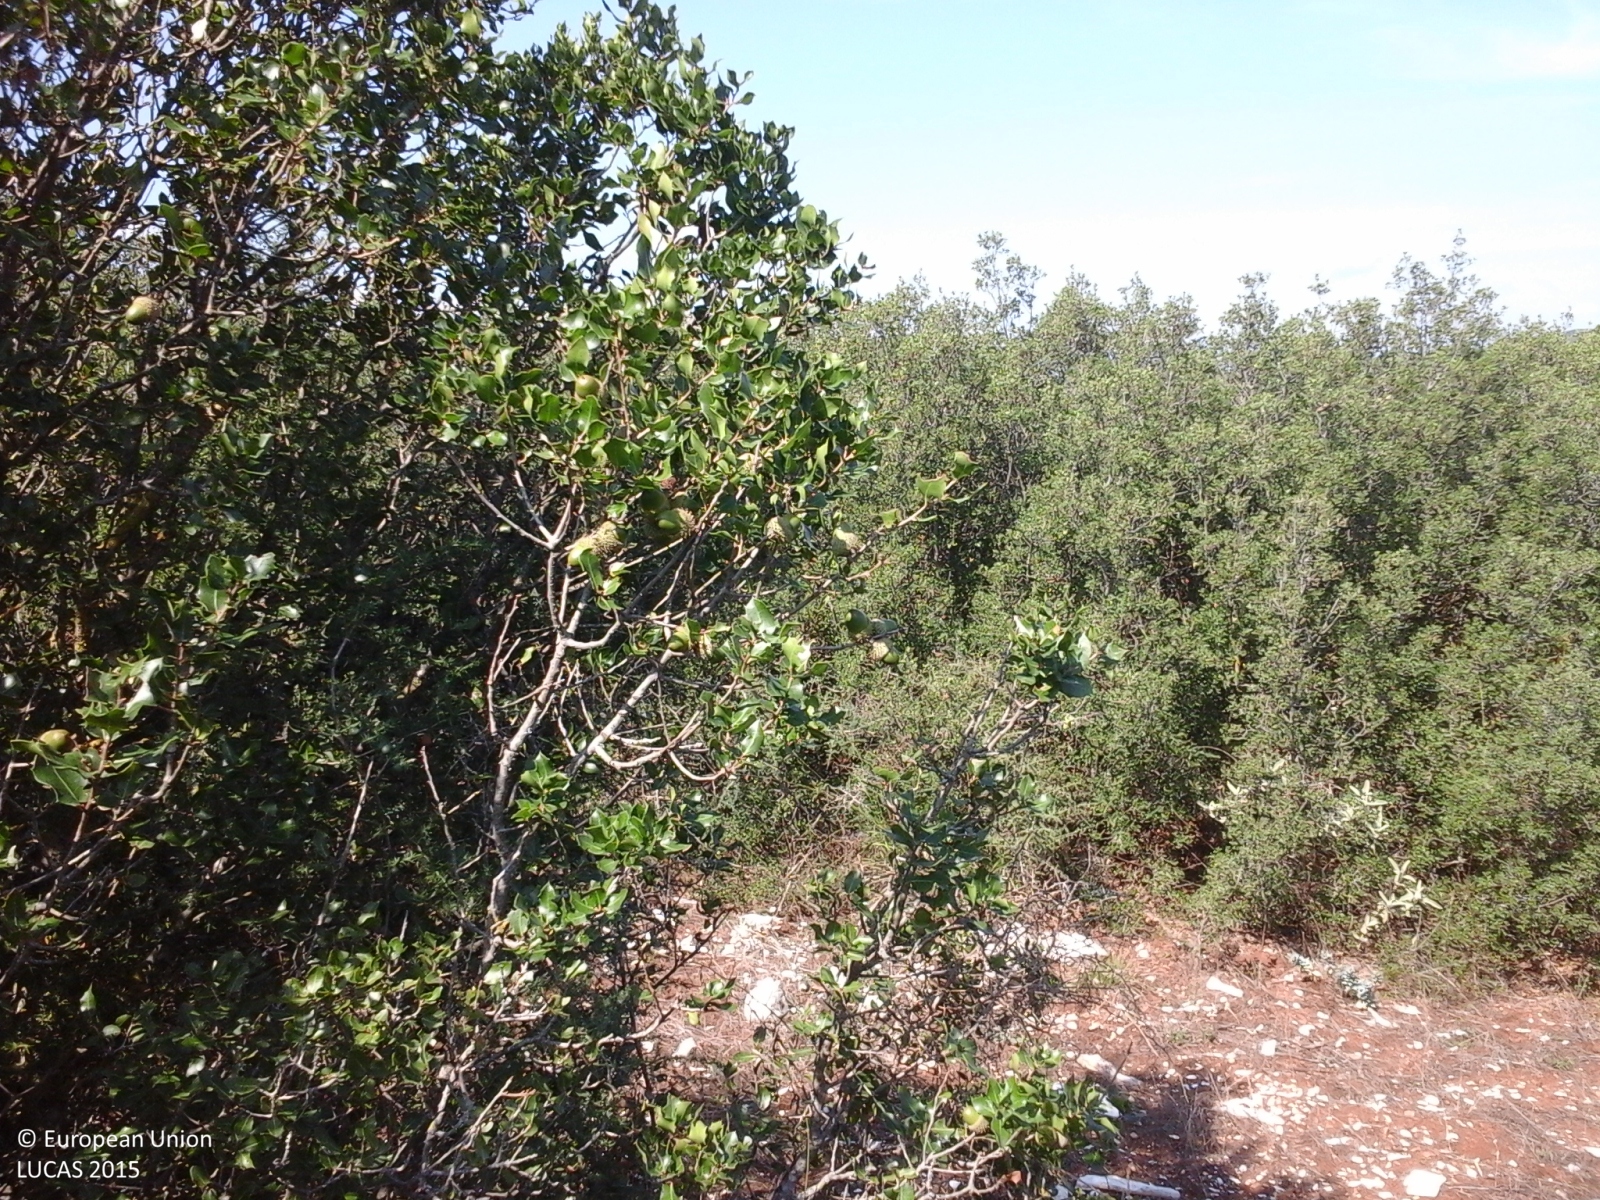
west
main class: Shrubland
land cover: Shrubland with sparse tree cover
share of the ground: 50 - 75 %
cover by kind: shrubs 65 %, herbaceous plants 20 %, unconsolidated bare surface 10 %, broadleaved forest trees 5 %
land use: Semi-natural and natural areas not in use
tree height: < 5 m
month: September
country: GR
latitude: 39.7734
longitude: 20.6844
